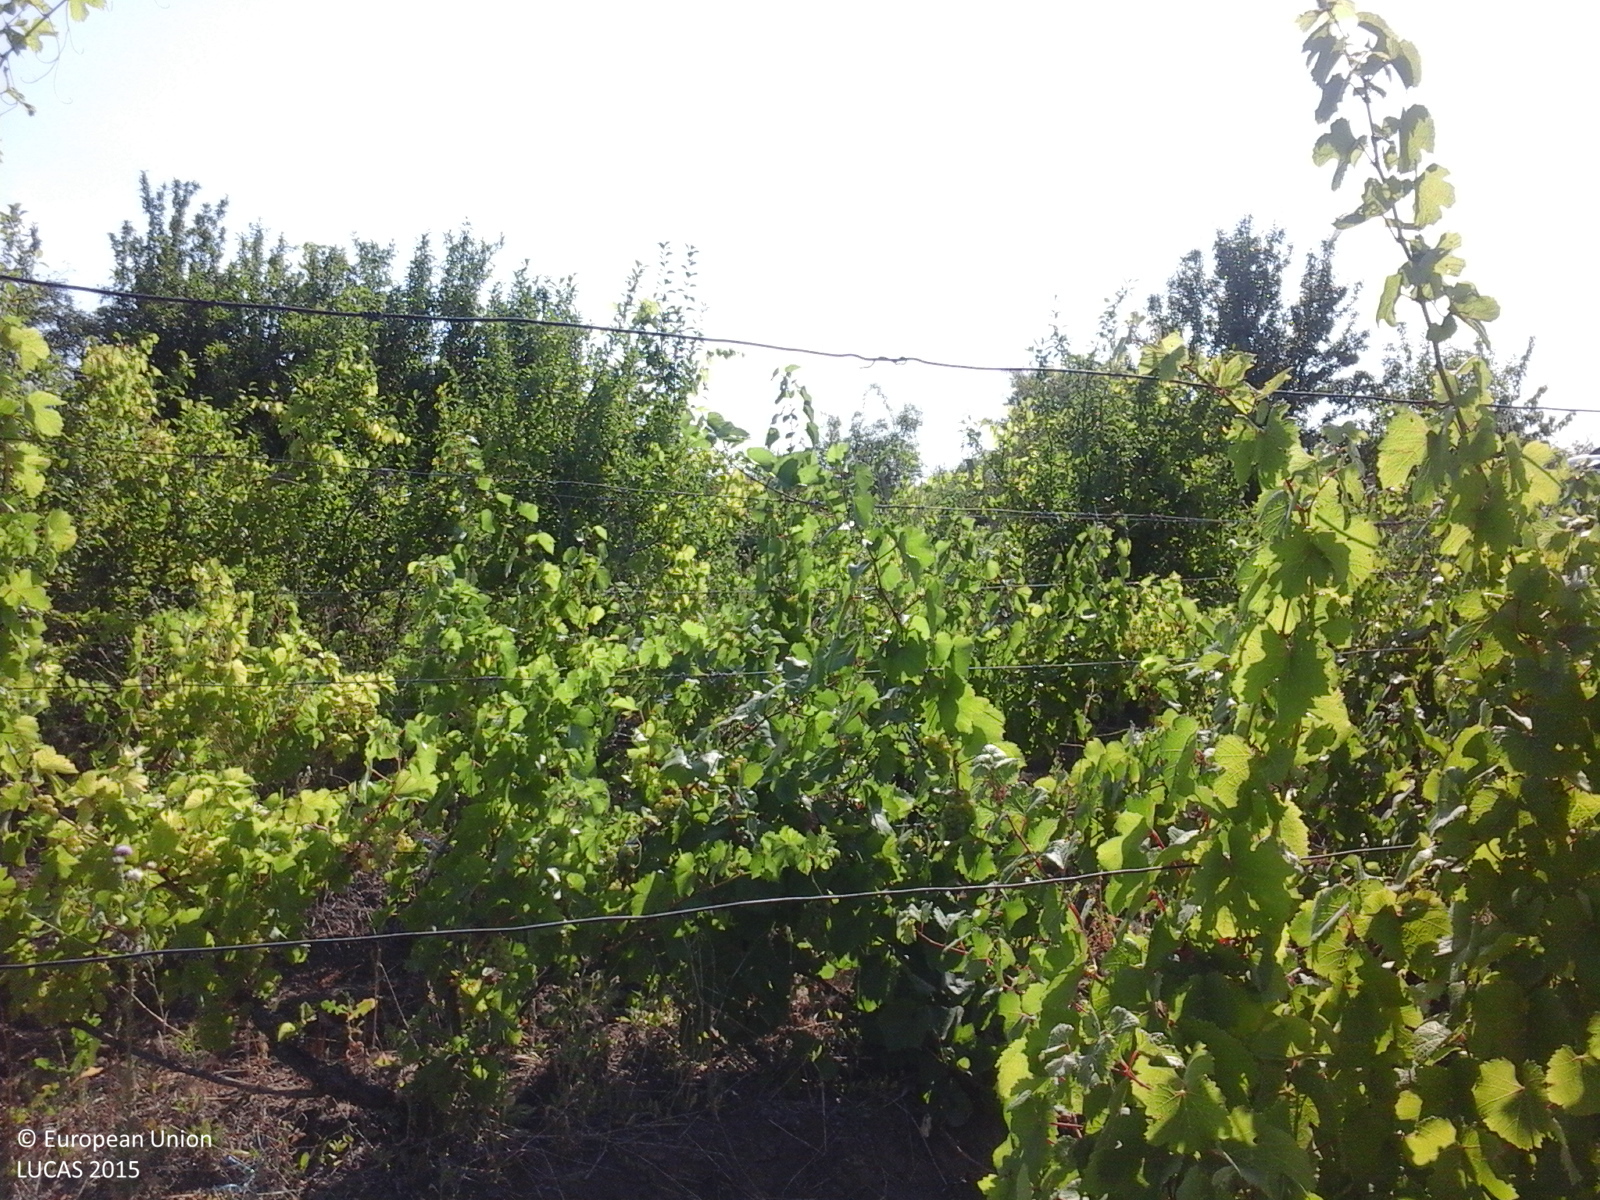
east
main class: Cropland
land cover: Vineyards
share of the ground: 50 - 75 %
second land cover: Other bare soil
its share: > 75 %
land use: Agriculture (excluding fallow land and kitchen gardens)
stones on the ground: < 10 %
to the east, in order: Vineyards; Other bare soil; Tracks; Vineyards; Abandoned hedges; Tracks; Abandoned hedges; Vineyards; Tracks; Vineyards; Abandoned hedges; Spontaneously vegetated surfaces; Sunflower
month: July
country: RO
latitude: 46.0963
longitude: 28.0124
